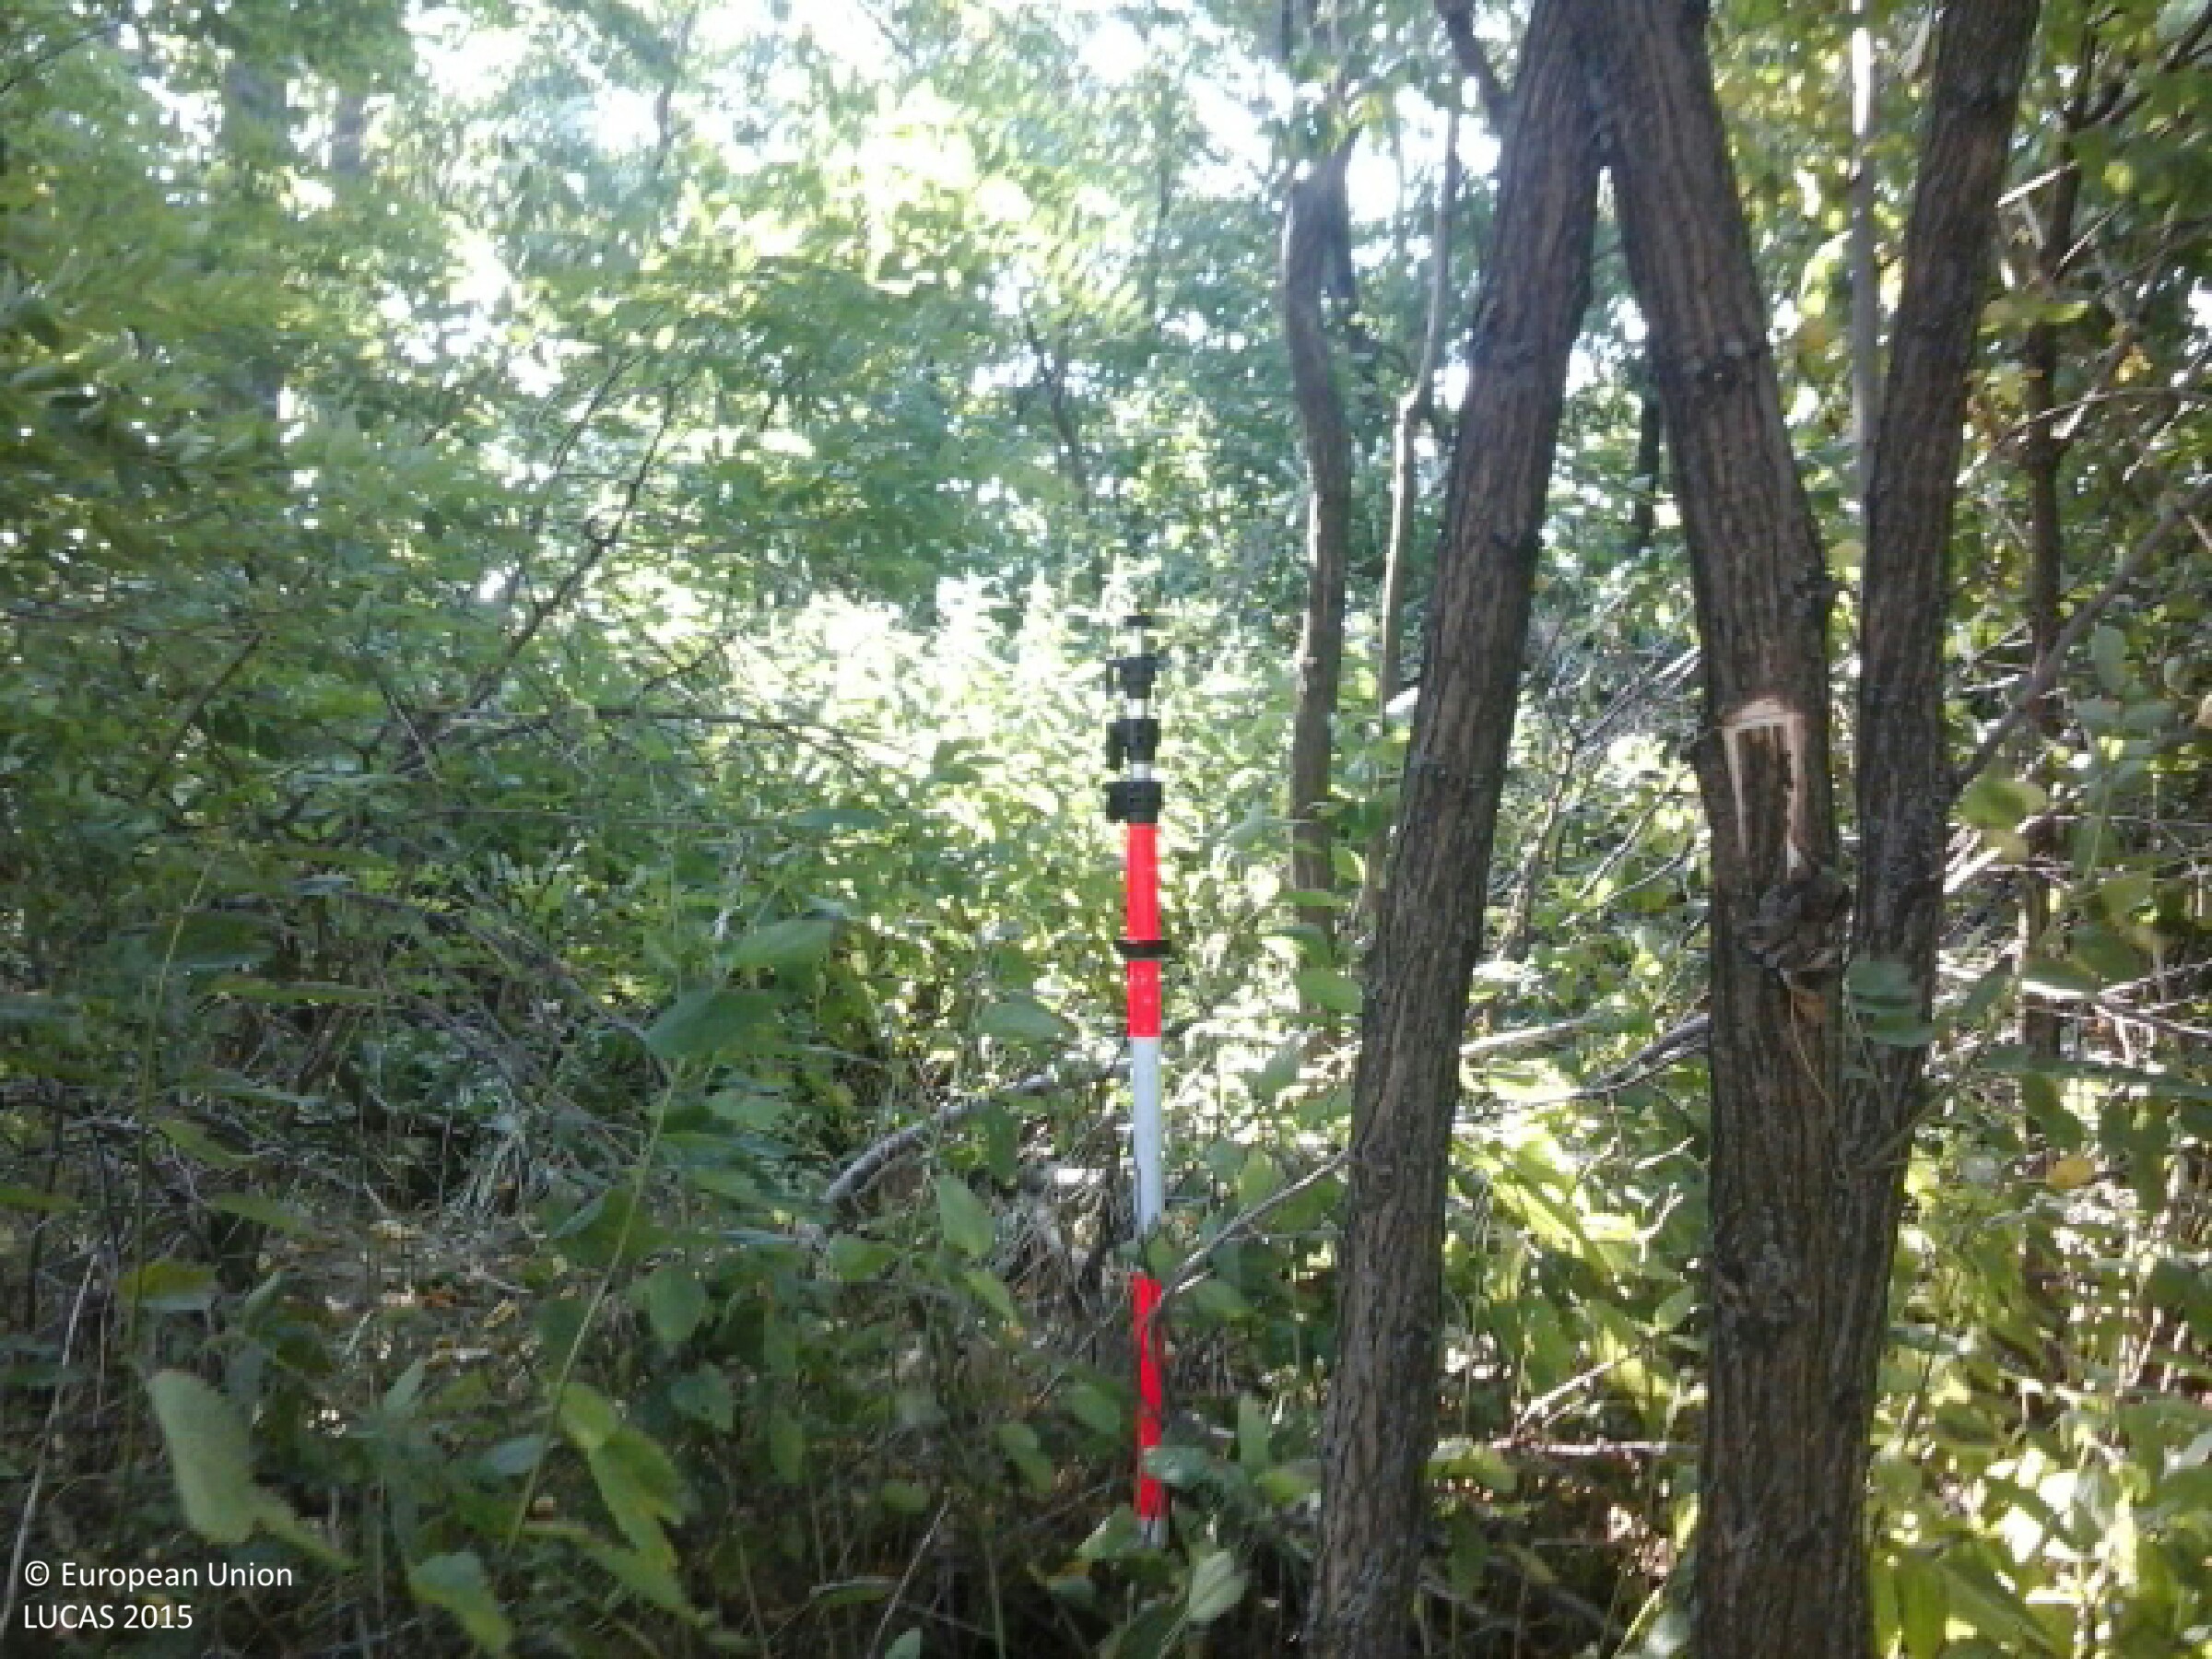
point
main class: Woodland
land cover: Broadleaved woodland
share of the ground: > 75 %
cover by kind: broadleaved forest trees 95 %, shrubs 5 %
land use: Forestry
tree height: < 5 m
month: July
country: HU
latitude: 48.2098
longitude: 21.0618
